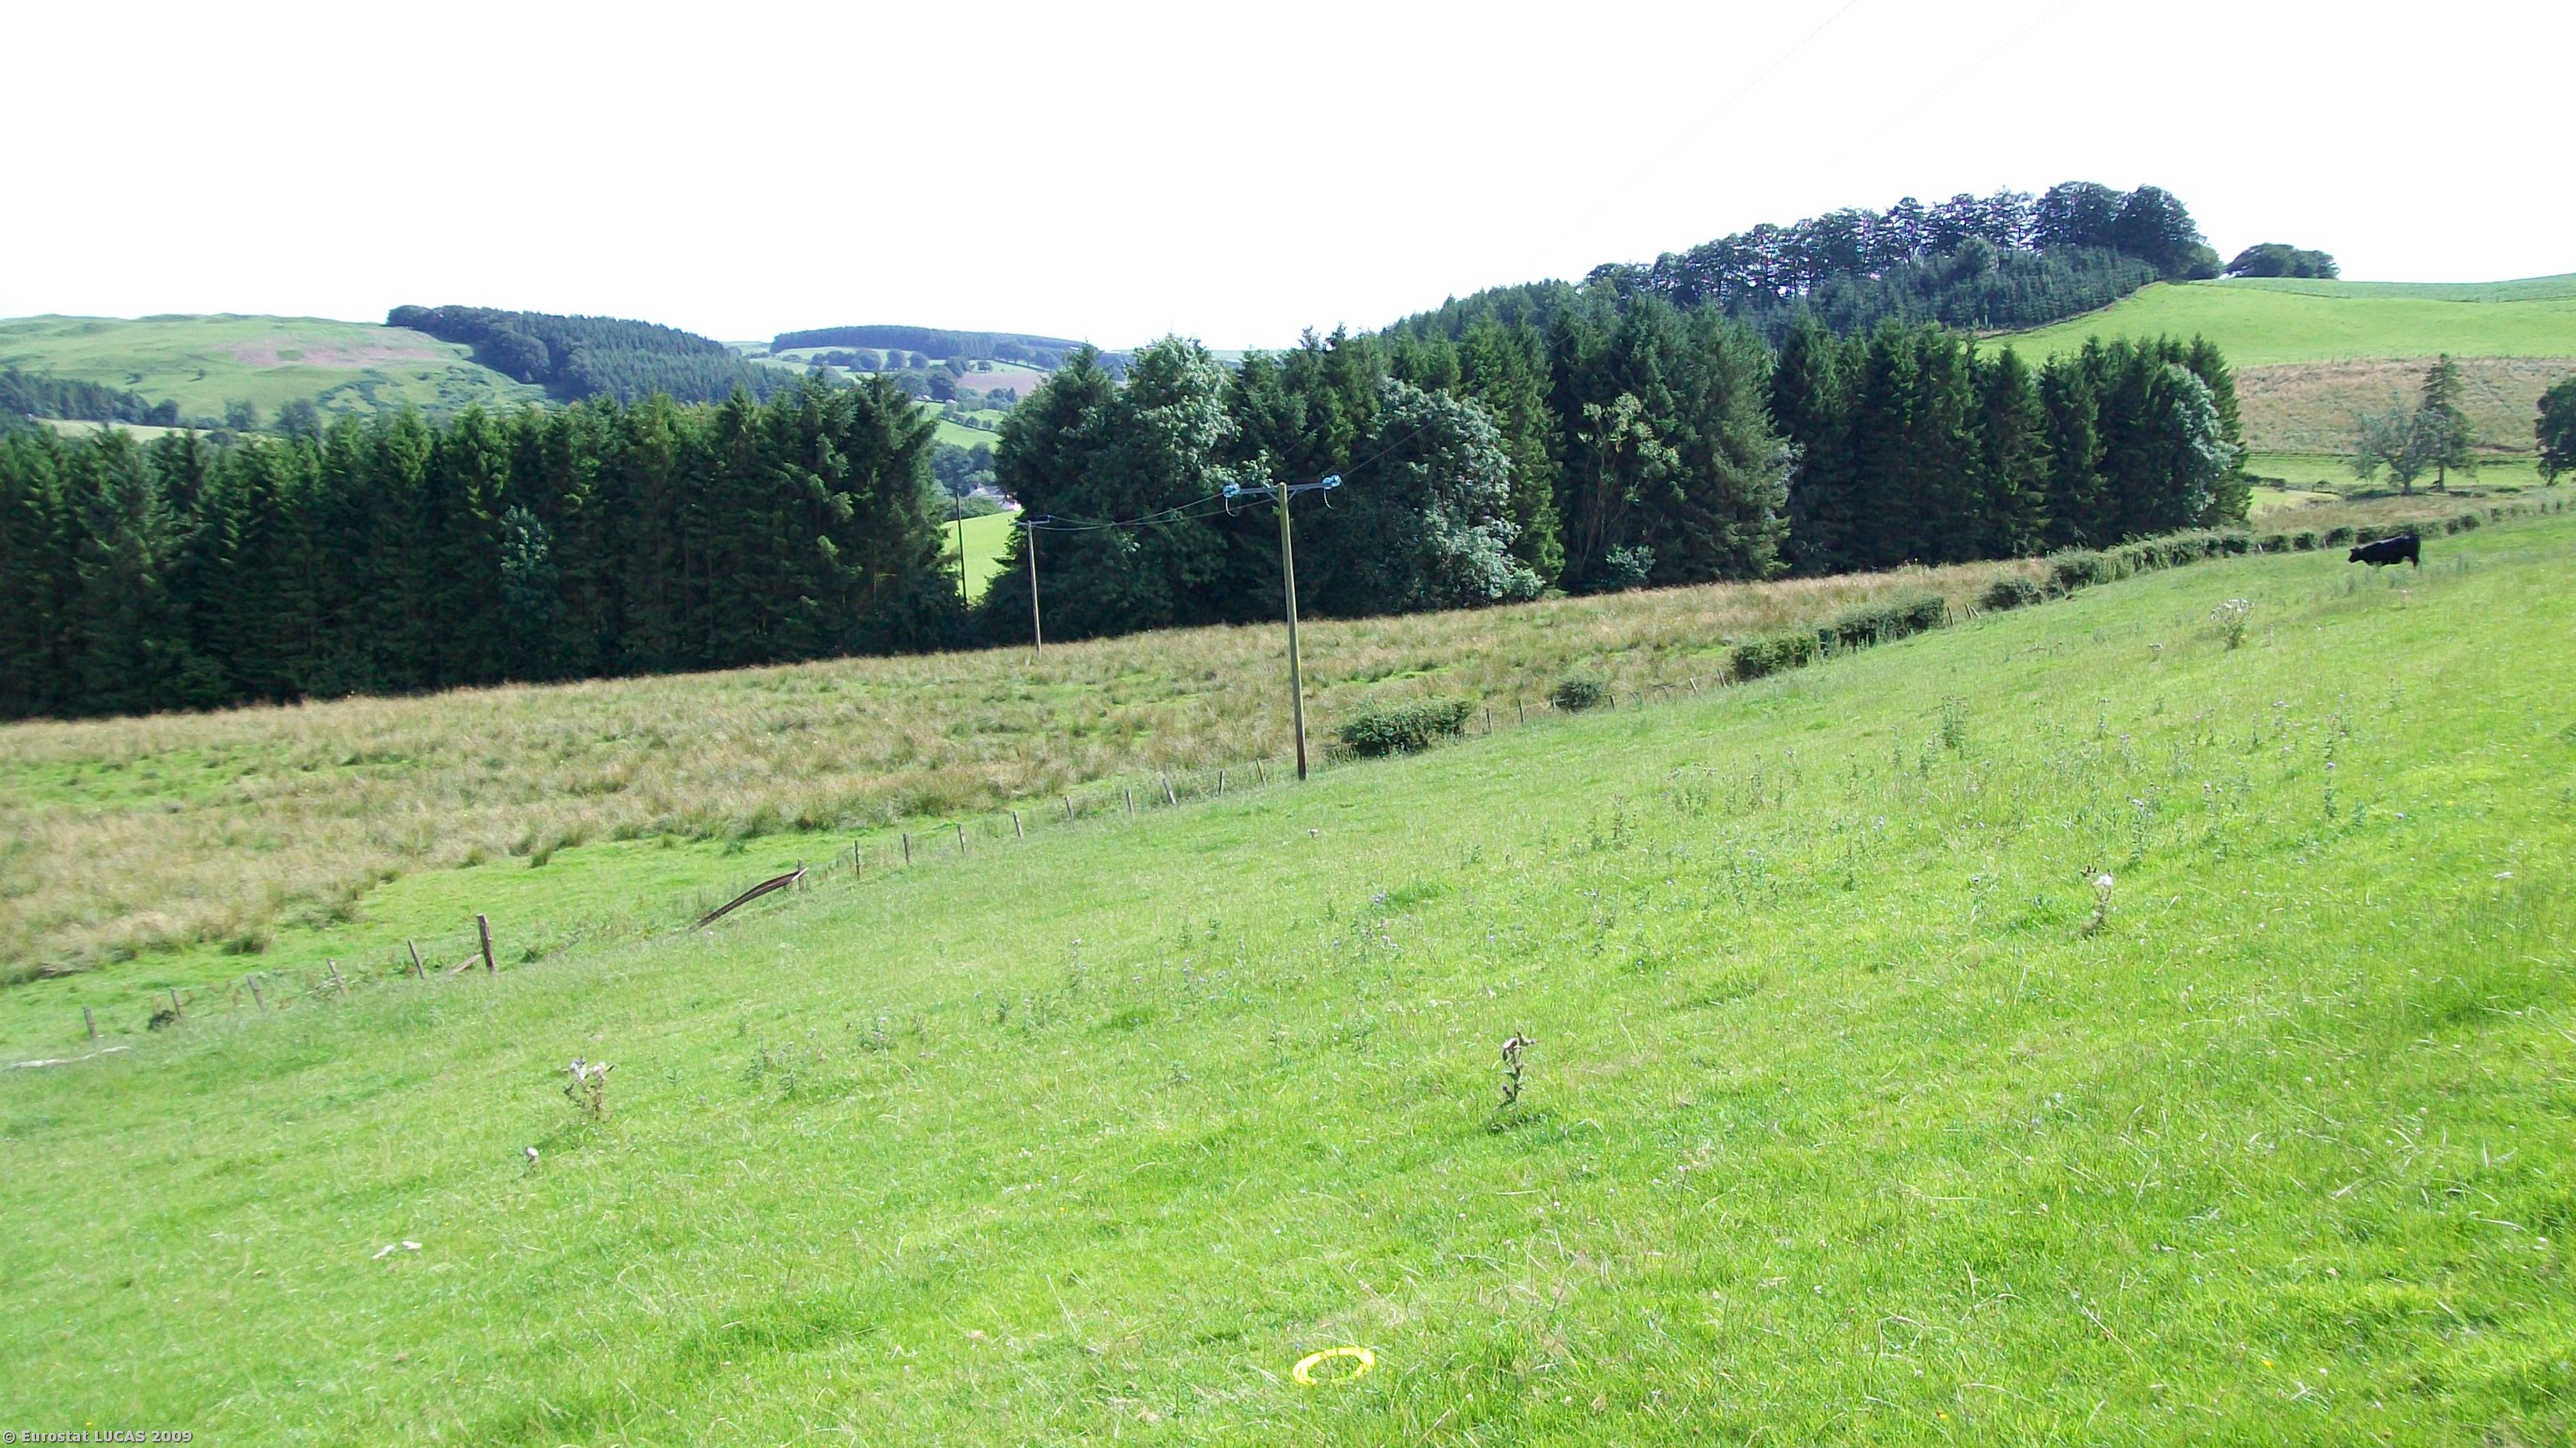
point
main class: Grassland
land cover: Grassland without tree/shrub cover
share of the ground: > 75 %
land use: Agriculture (excluding fallow land and kitchen gardens)
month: August
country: GB
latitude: 55.1939
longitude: -3.3512
